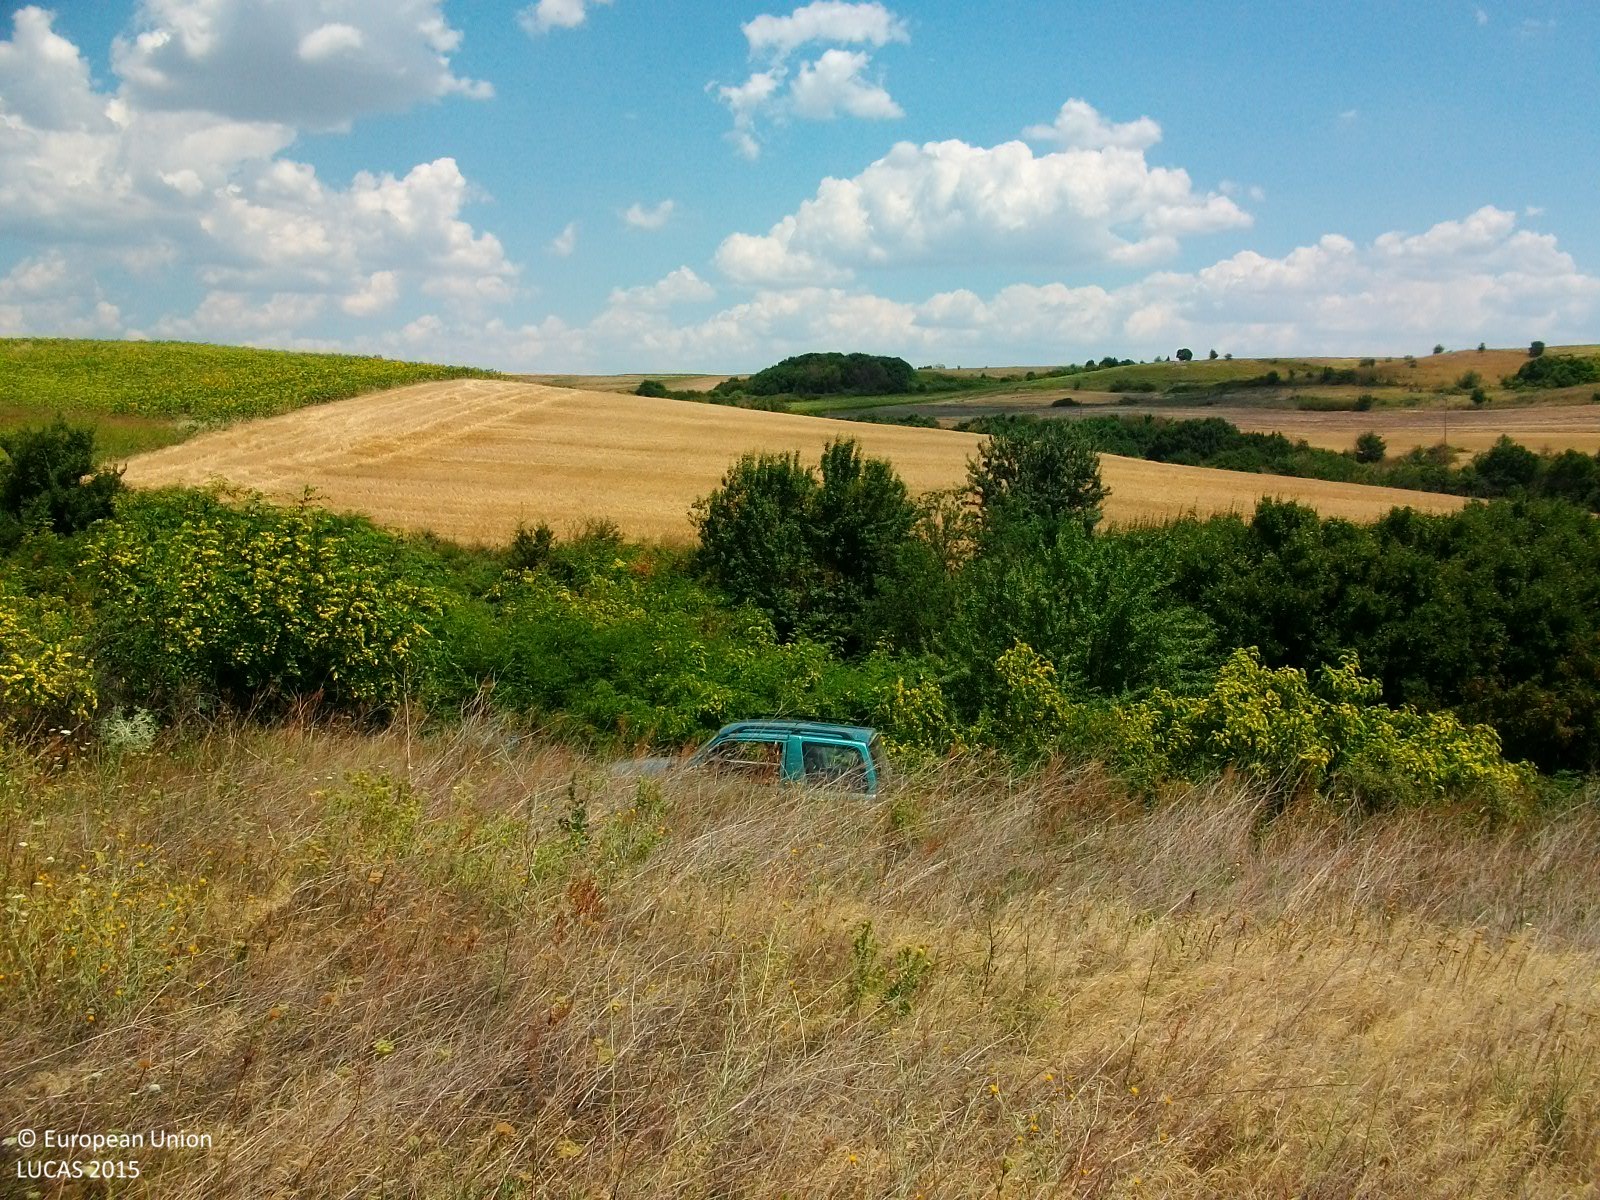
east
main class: Grassland
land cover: Spontaneously vegetated surfaces
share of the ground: > 75 %
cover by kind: herbaceous plants 100 %
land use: Fallow land
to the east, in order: Spontaneously vegetated surfaces; Tracks; Shruby margins; Broadleaved woodland; Shruby margins; Tracks; Grass margins; Common wheat; Spontaneously vegetated surfaces; Shrubland with sparse tree cover; Paved roads, cycling and walking lanes
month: July
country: GR
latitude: 41.6818
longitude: 26.3558
